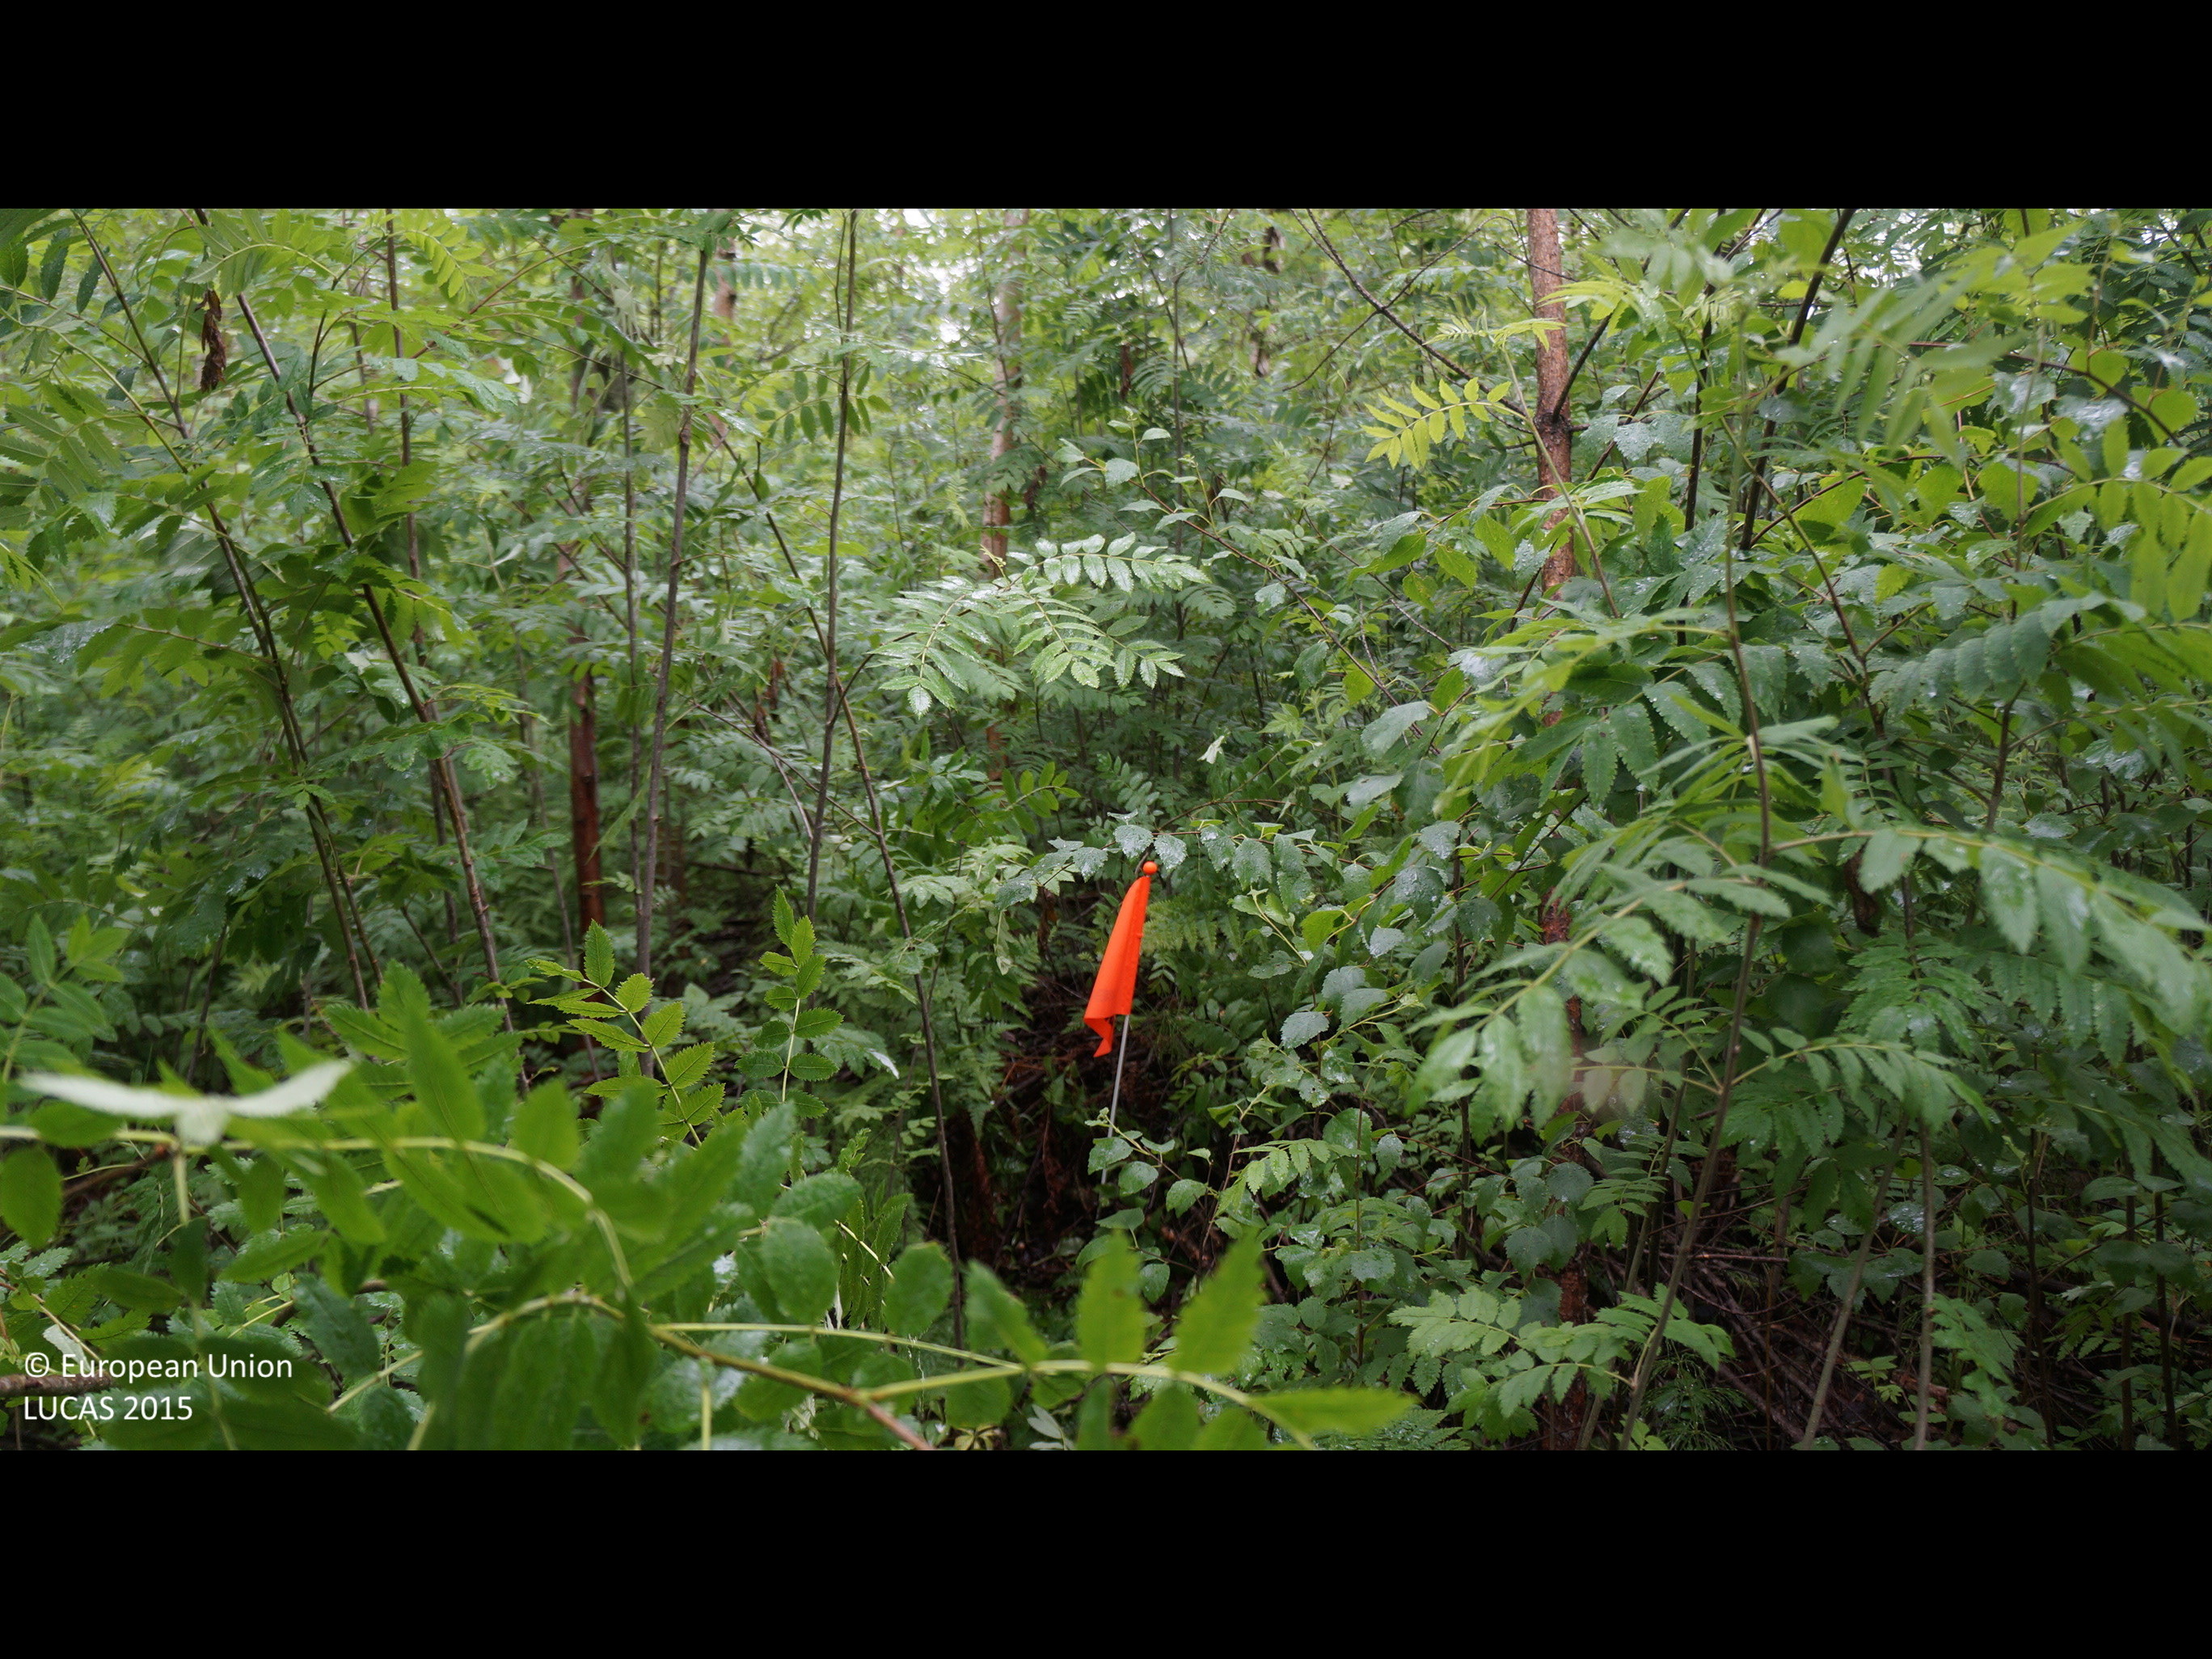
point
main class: Woodland
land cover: Broadleaved woodland
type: non-riverine alder, birch or aspen forest
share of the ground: > 75 %
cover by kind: broadleaved forest trees 90 %, shrubs 10 %
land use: Forestry
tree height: > 5 m
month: June
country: FI
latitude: 64.6300
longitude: 25.2911
